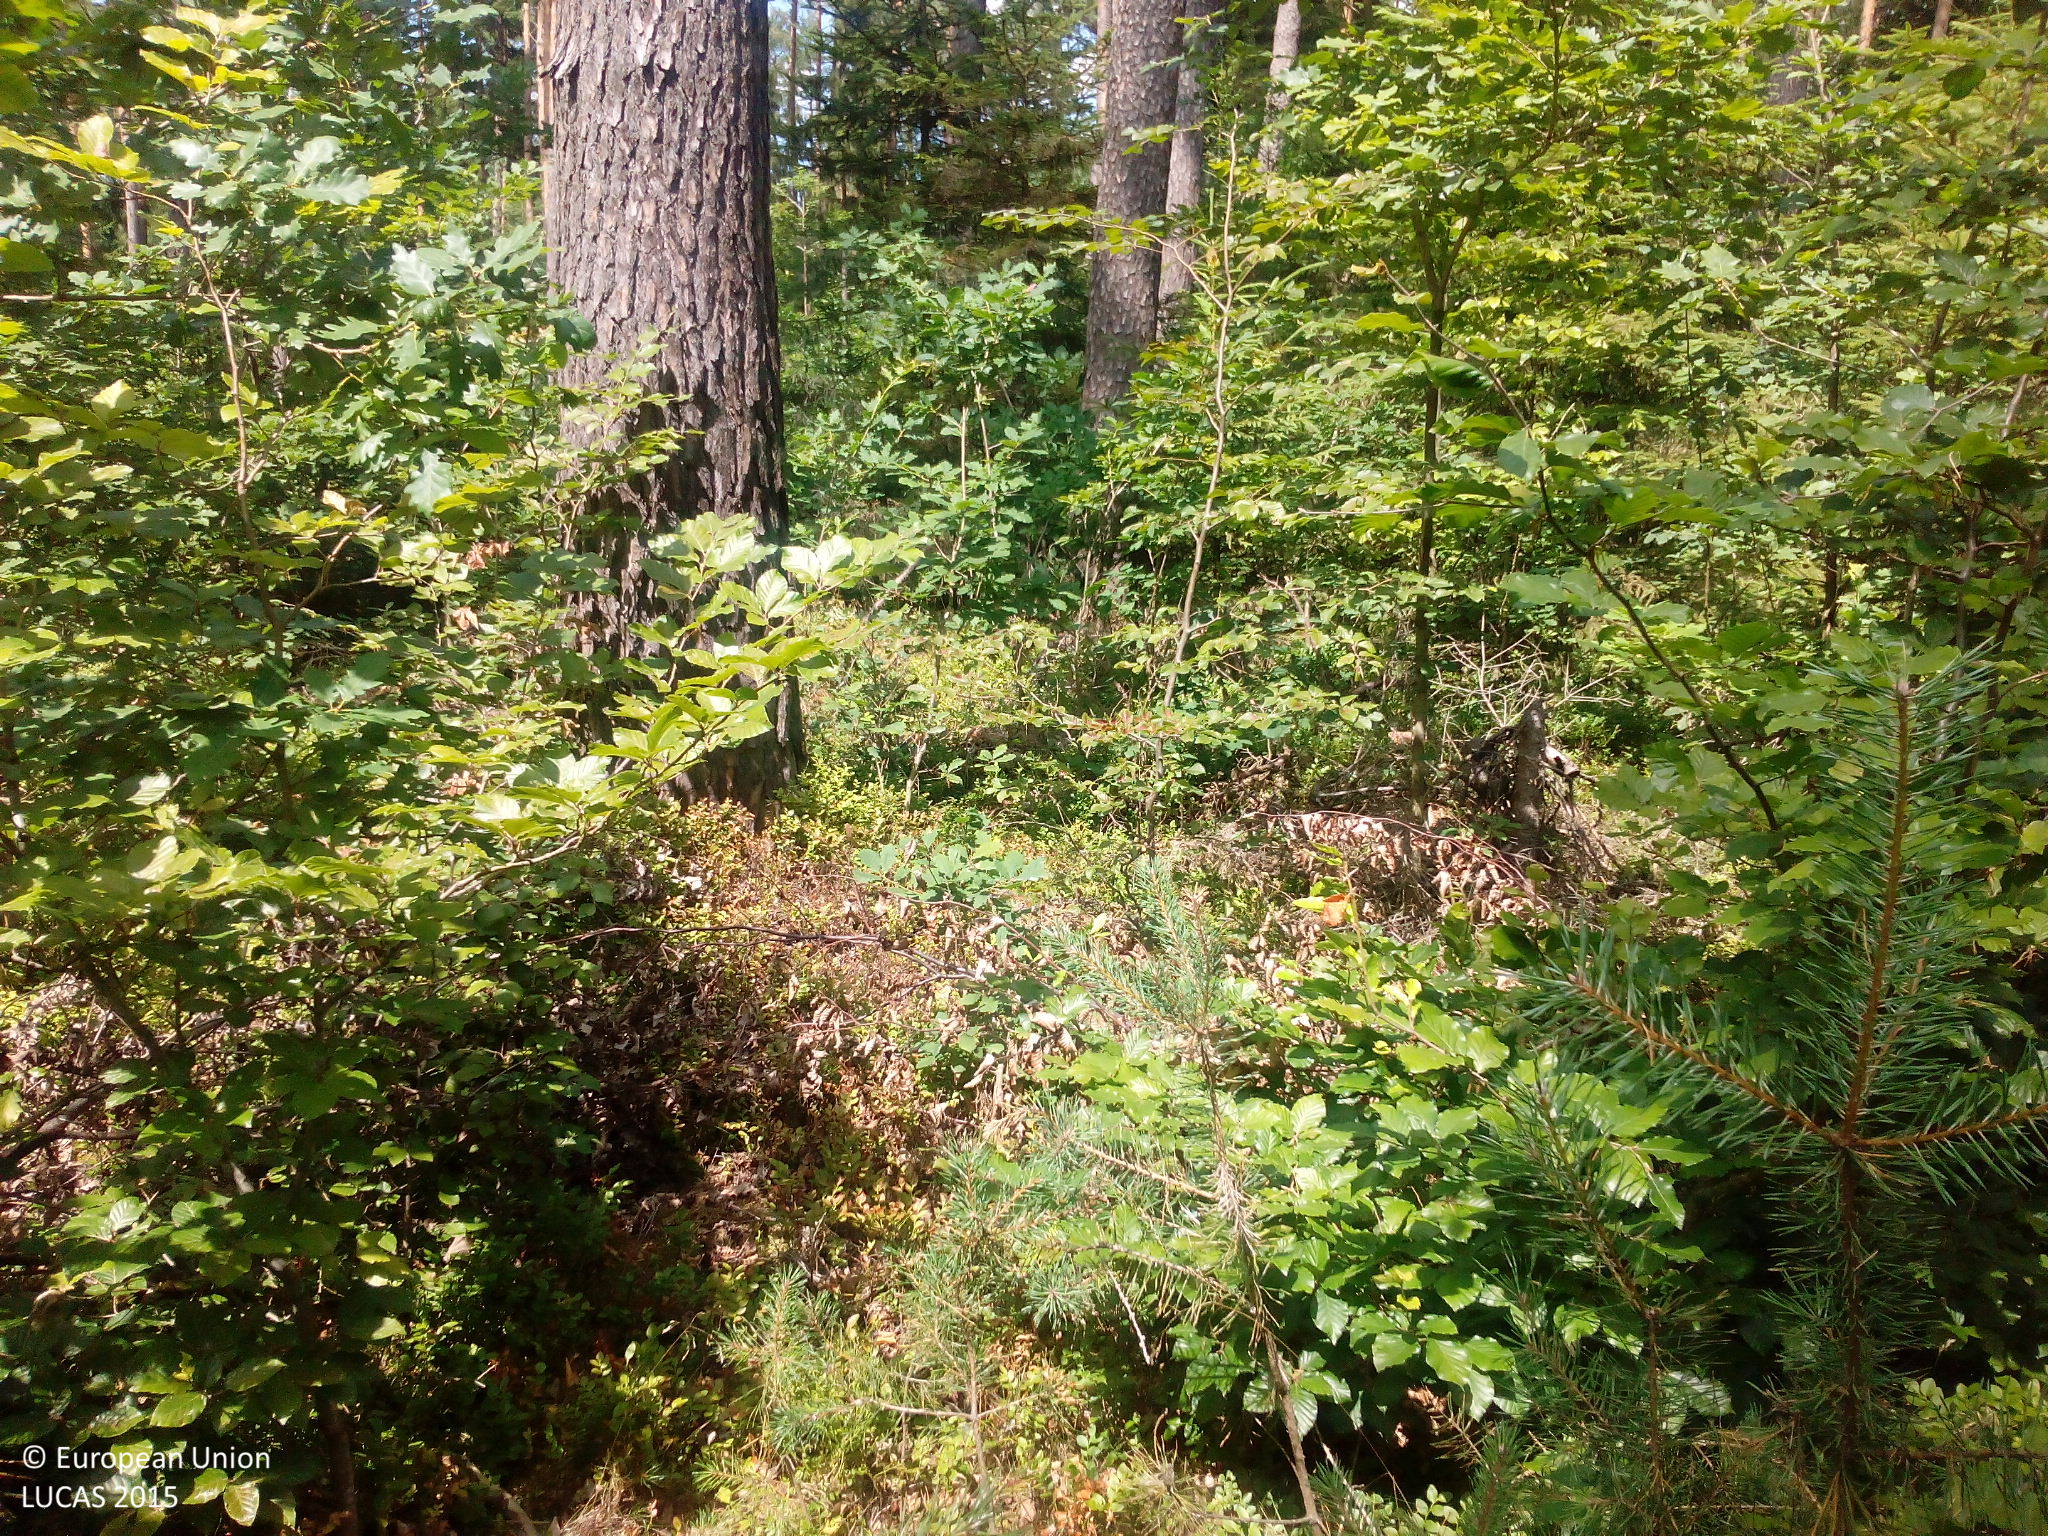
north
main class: Woodland
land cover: Pine dominated mixed woodland
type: hemiboreal forest and nemoral coniferous forest and mixed broadleaved-coniferous forest
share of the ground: > 75 %
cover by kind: broadleaved forest trees 45 %, coniferous forest trees 35 %, shrubs 10 %, lichens and mosses 10 %
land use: Forestry
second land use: Amenities, museums, leisure
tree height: > 5 m
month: July
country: DE
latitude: 49.6771
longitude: 10.9005
